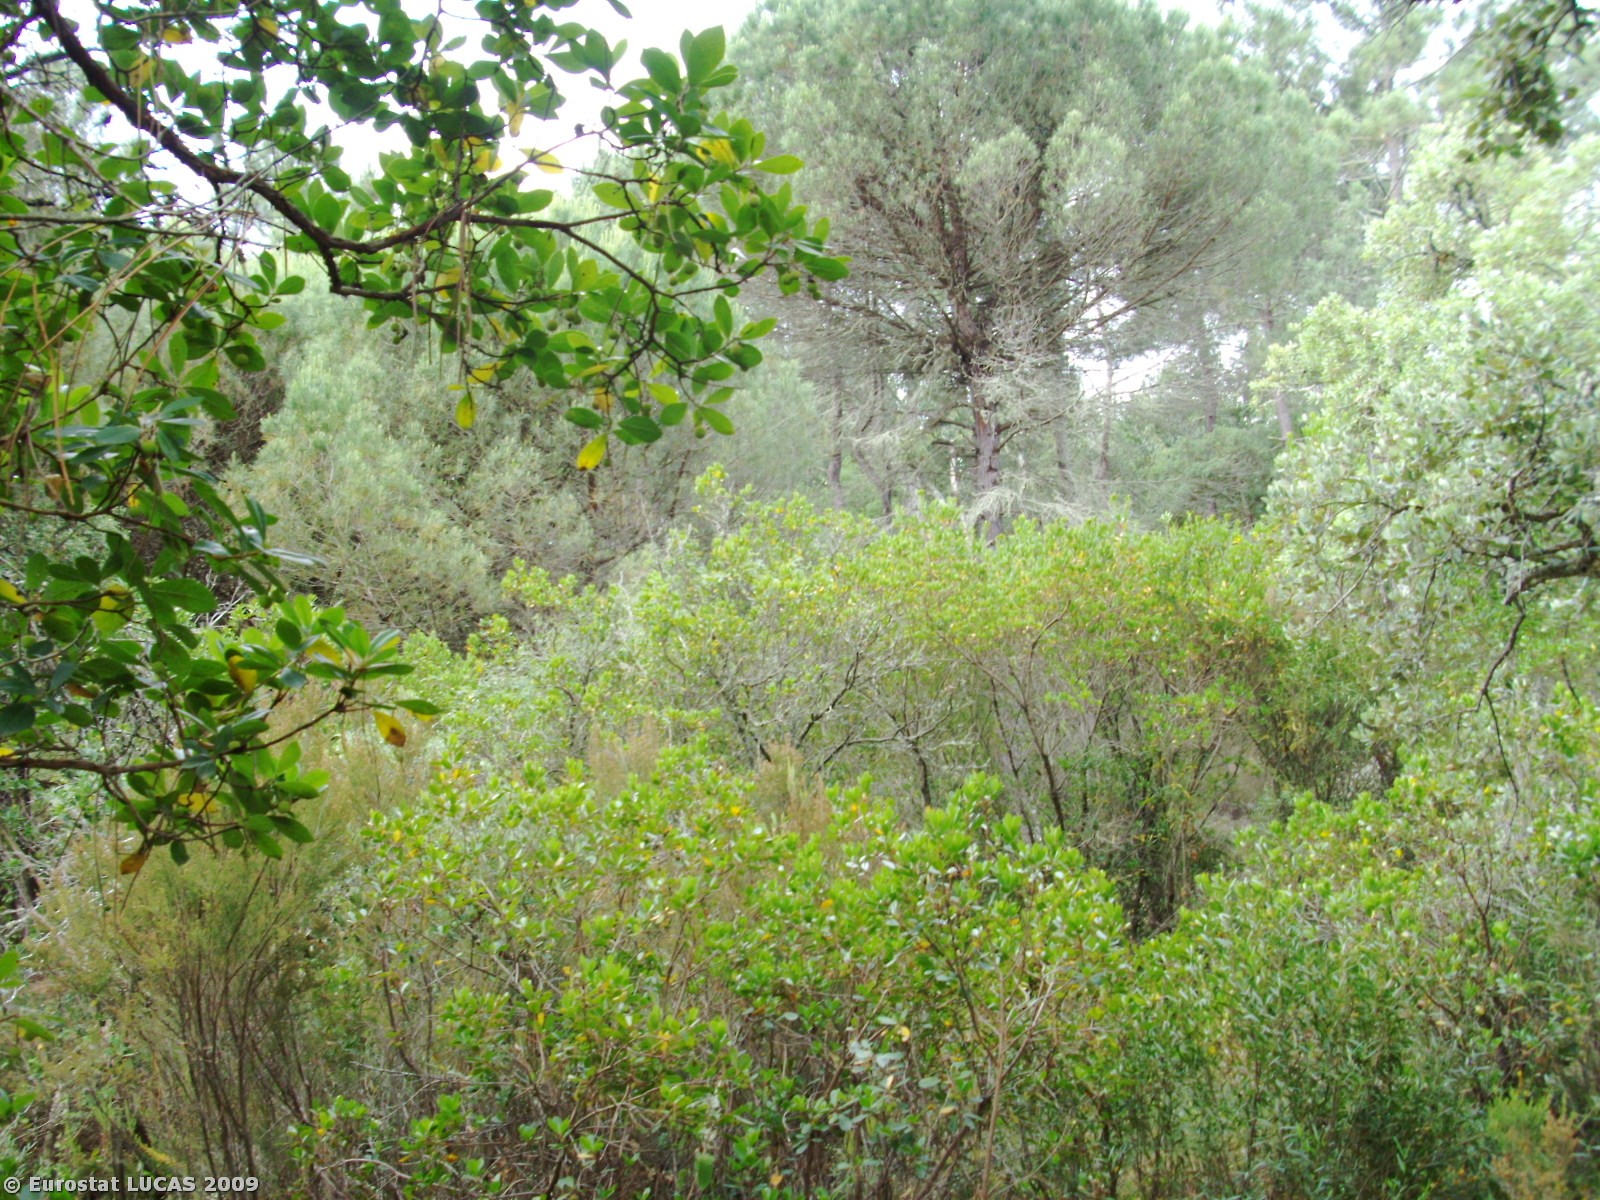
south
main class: Woodland
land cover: Coniferous woodland
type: coniferous forest of the mediterranean region
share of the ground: 25 - 50 %
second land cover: Shrubland with sparse tree cover
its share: 50 - 75 %
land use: Forestry
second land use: Nature reserves
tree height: > 5 m
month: June
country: PT
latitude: 37.1214
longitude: -8.8628
